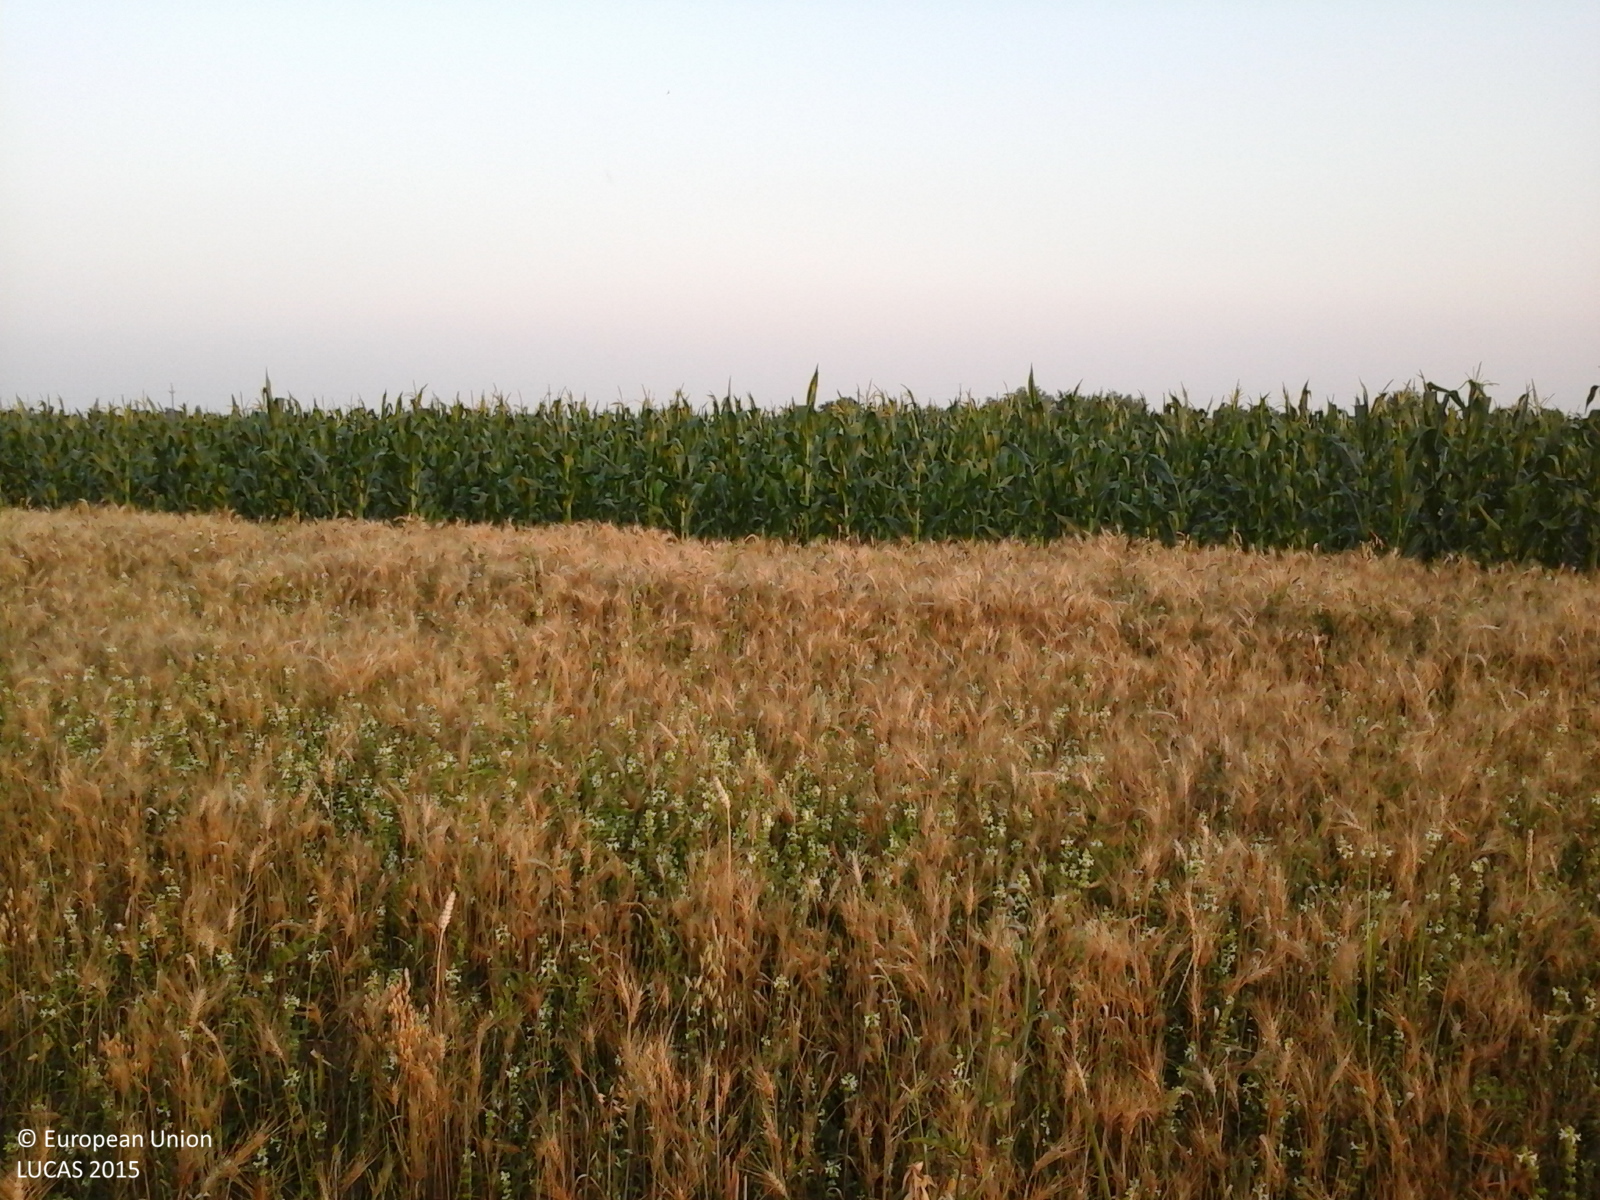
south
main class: Cropland
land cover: Barley
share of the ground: > 75 %
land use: Agriculture (excluding fallow land and kitchen gardens)
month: July
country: RO
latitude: 44.8134
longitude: 25.7162
